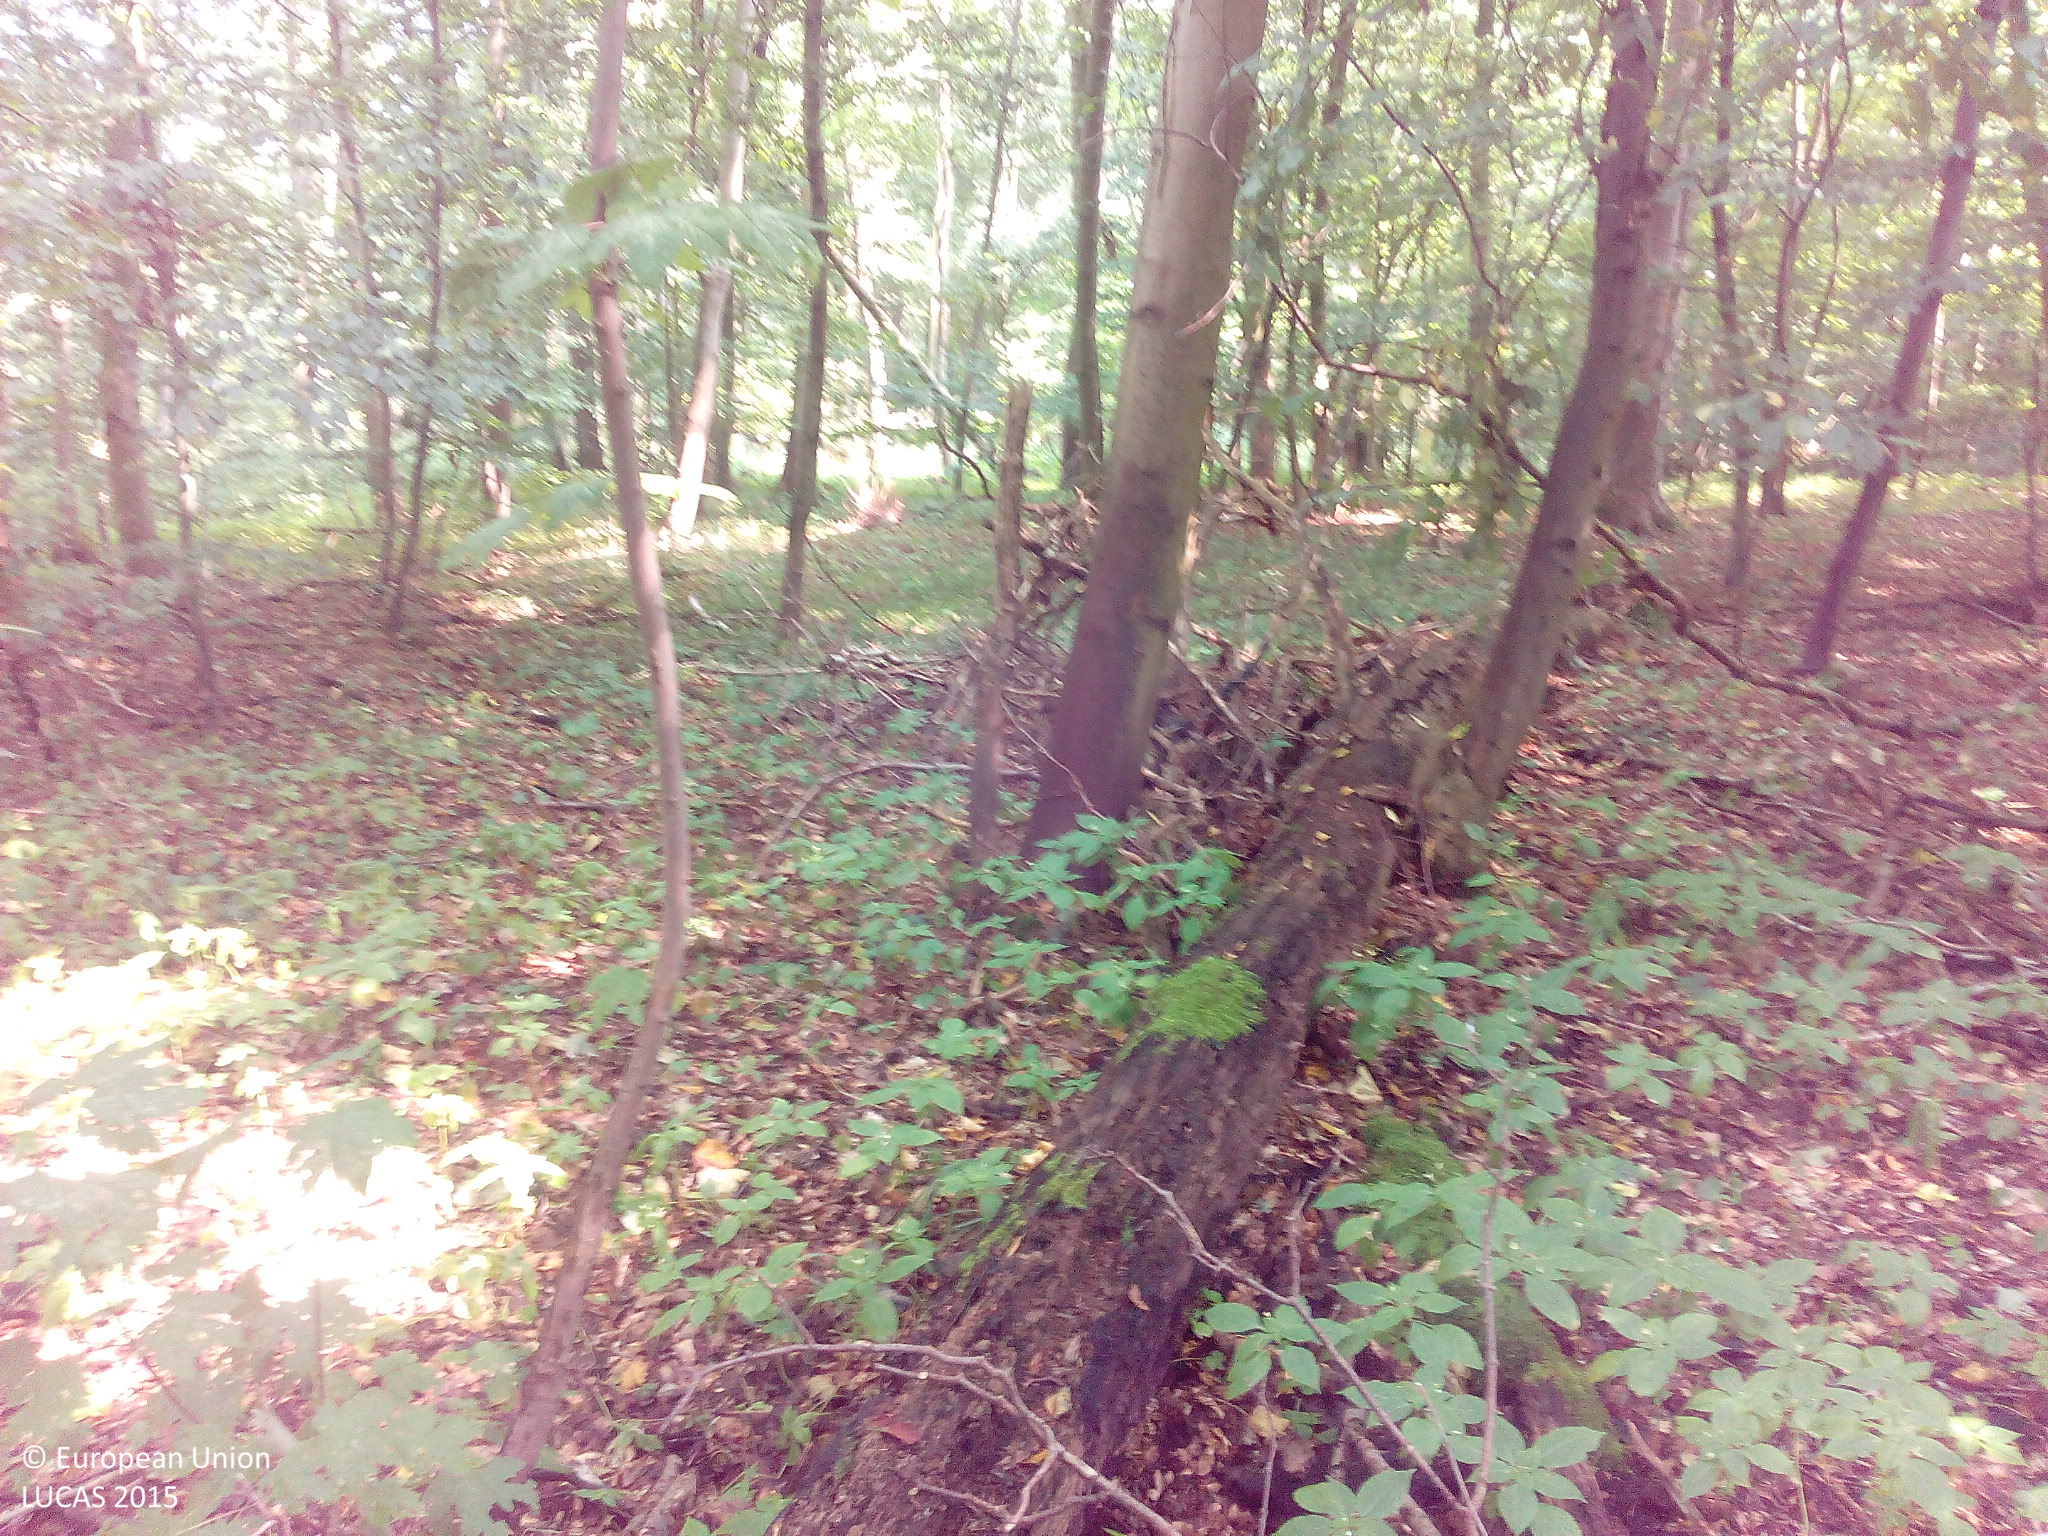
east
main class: Woodland
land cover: Broadleaved woodland
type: mesophytic deciduous forest
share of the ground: > 75 %
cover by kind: broadleaved forest trees 95 %, herbaceous plants 5 %
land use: Forestry
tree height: > 5 m
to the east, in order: Broadleaved woodland
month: August
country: DE
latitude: 53.7938
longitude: 12.2915
